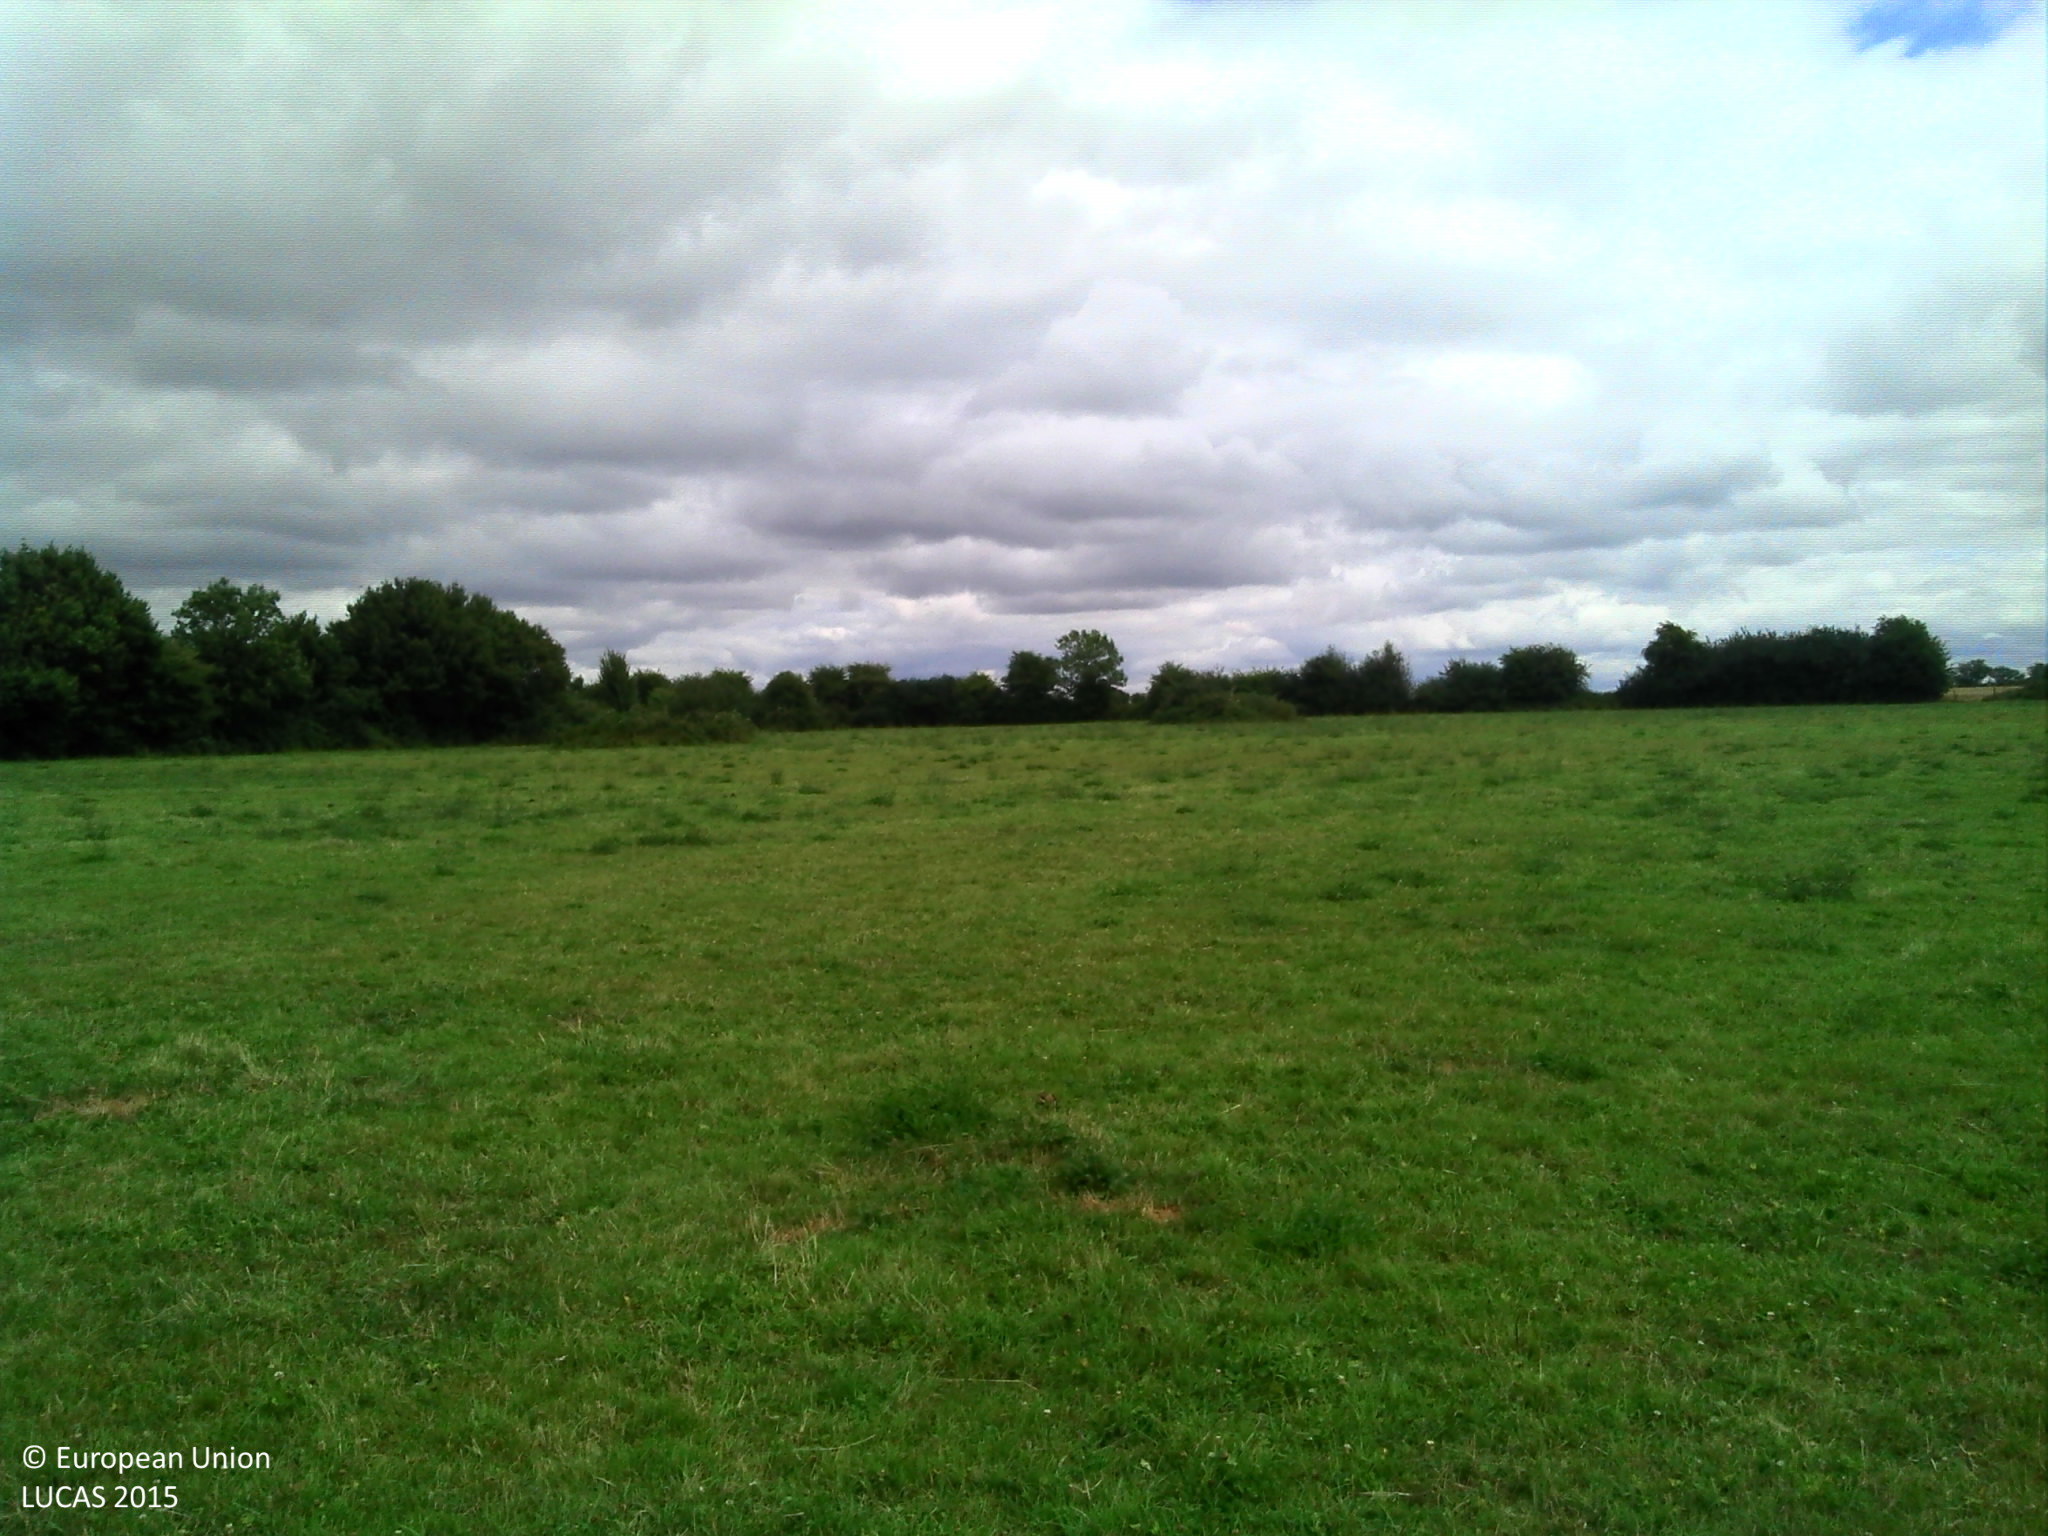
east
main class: Grassland
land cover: Grassland without tree/shrub cover
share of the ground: > 75 %
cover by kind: herbaceous plants 100 %
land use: Agriculture (excluding fallow land and kitchen gardens)
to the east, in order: Grassland without tree/shrub cover; Managed hedges; Common wheat
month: July
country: FR
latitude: 48.8608
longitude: 0.4734
